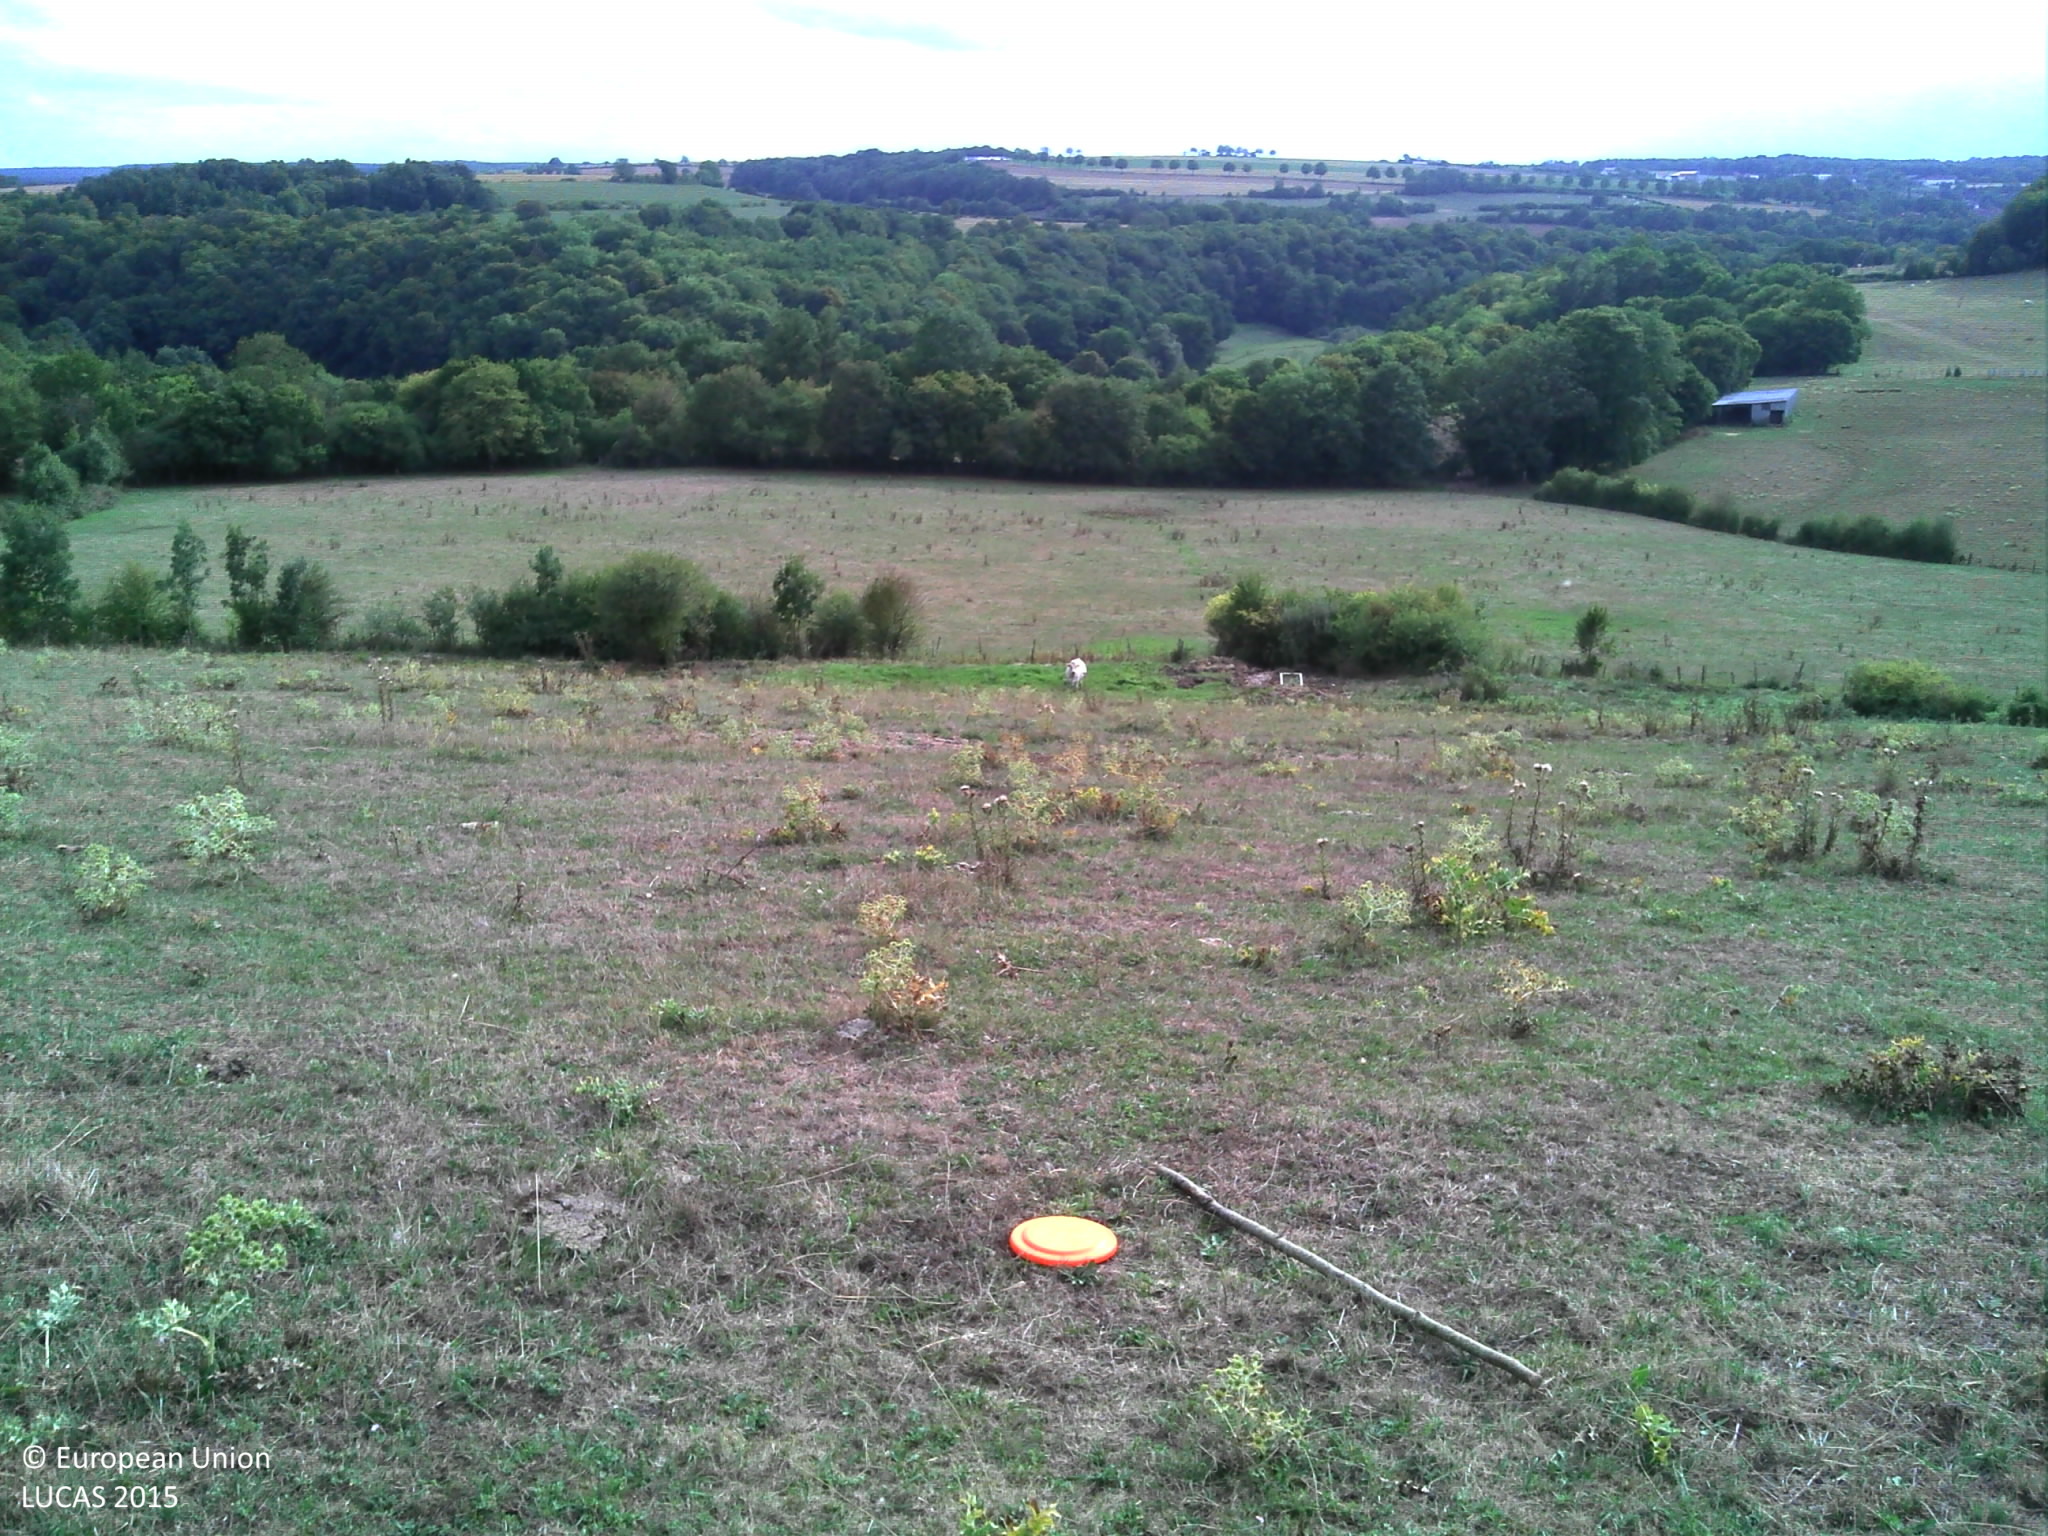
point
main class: Grassland
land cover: Grassland without tree/shrub cover
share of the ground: > 75 %
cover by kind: herbaceous plants 100 %
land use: Agriculture (excluding fallow land and kitchen gardens)
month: August
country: FR
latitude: 47.7074
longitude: 4.8683
